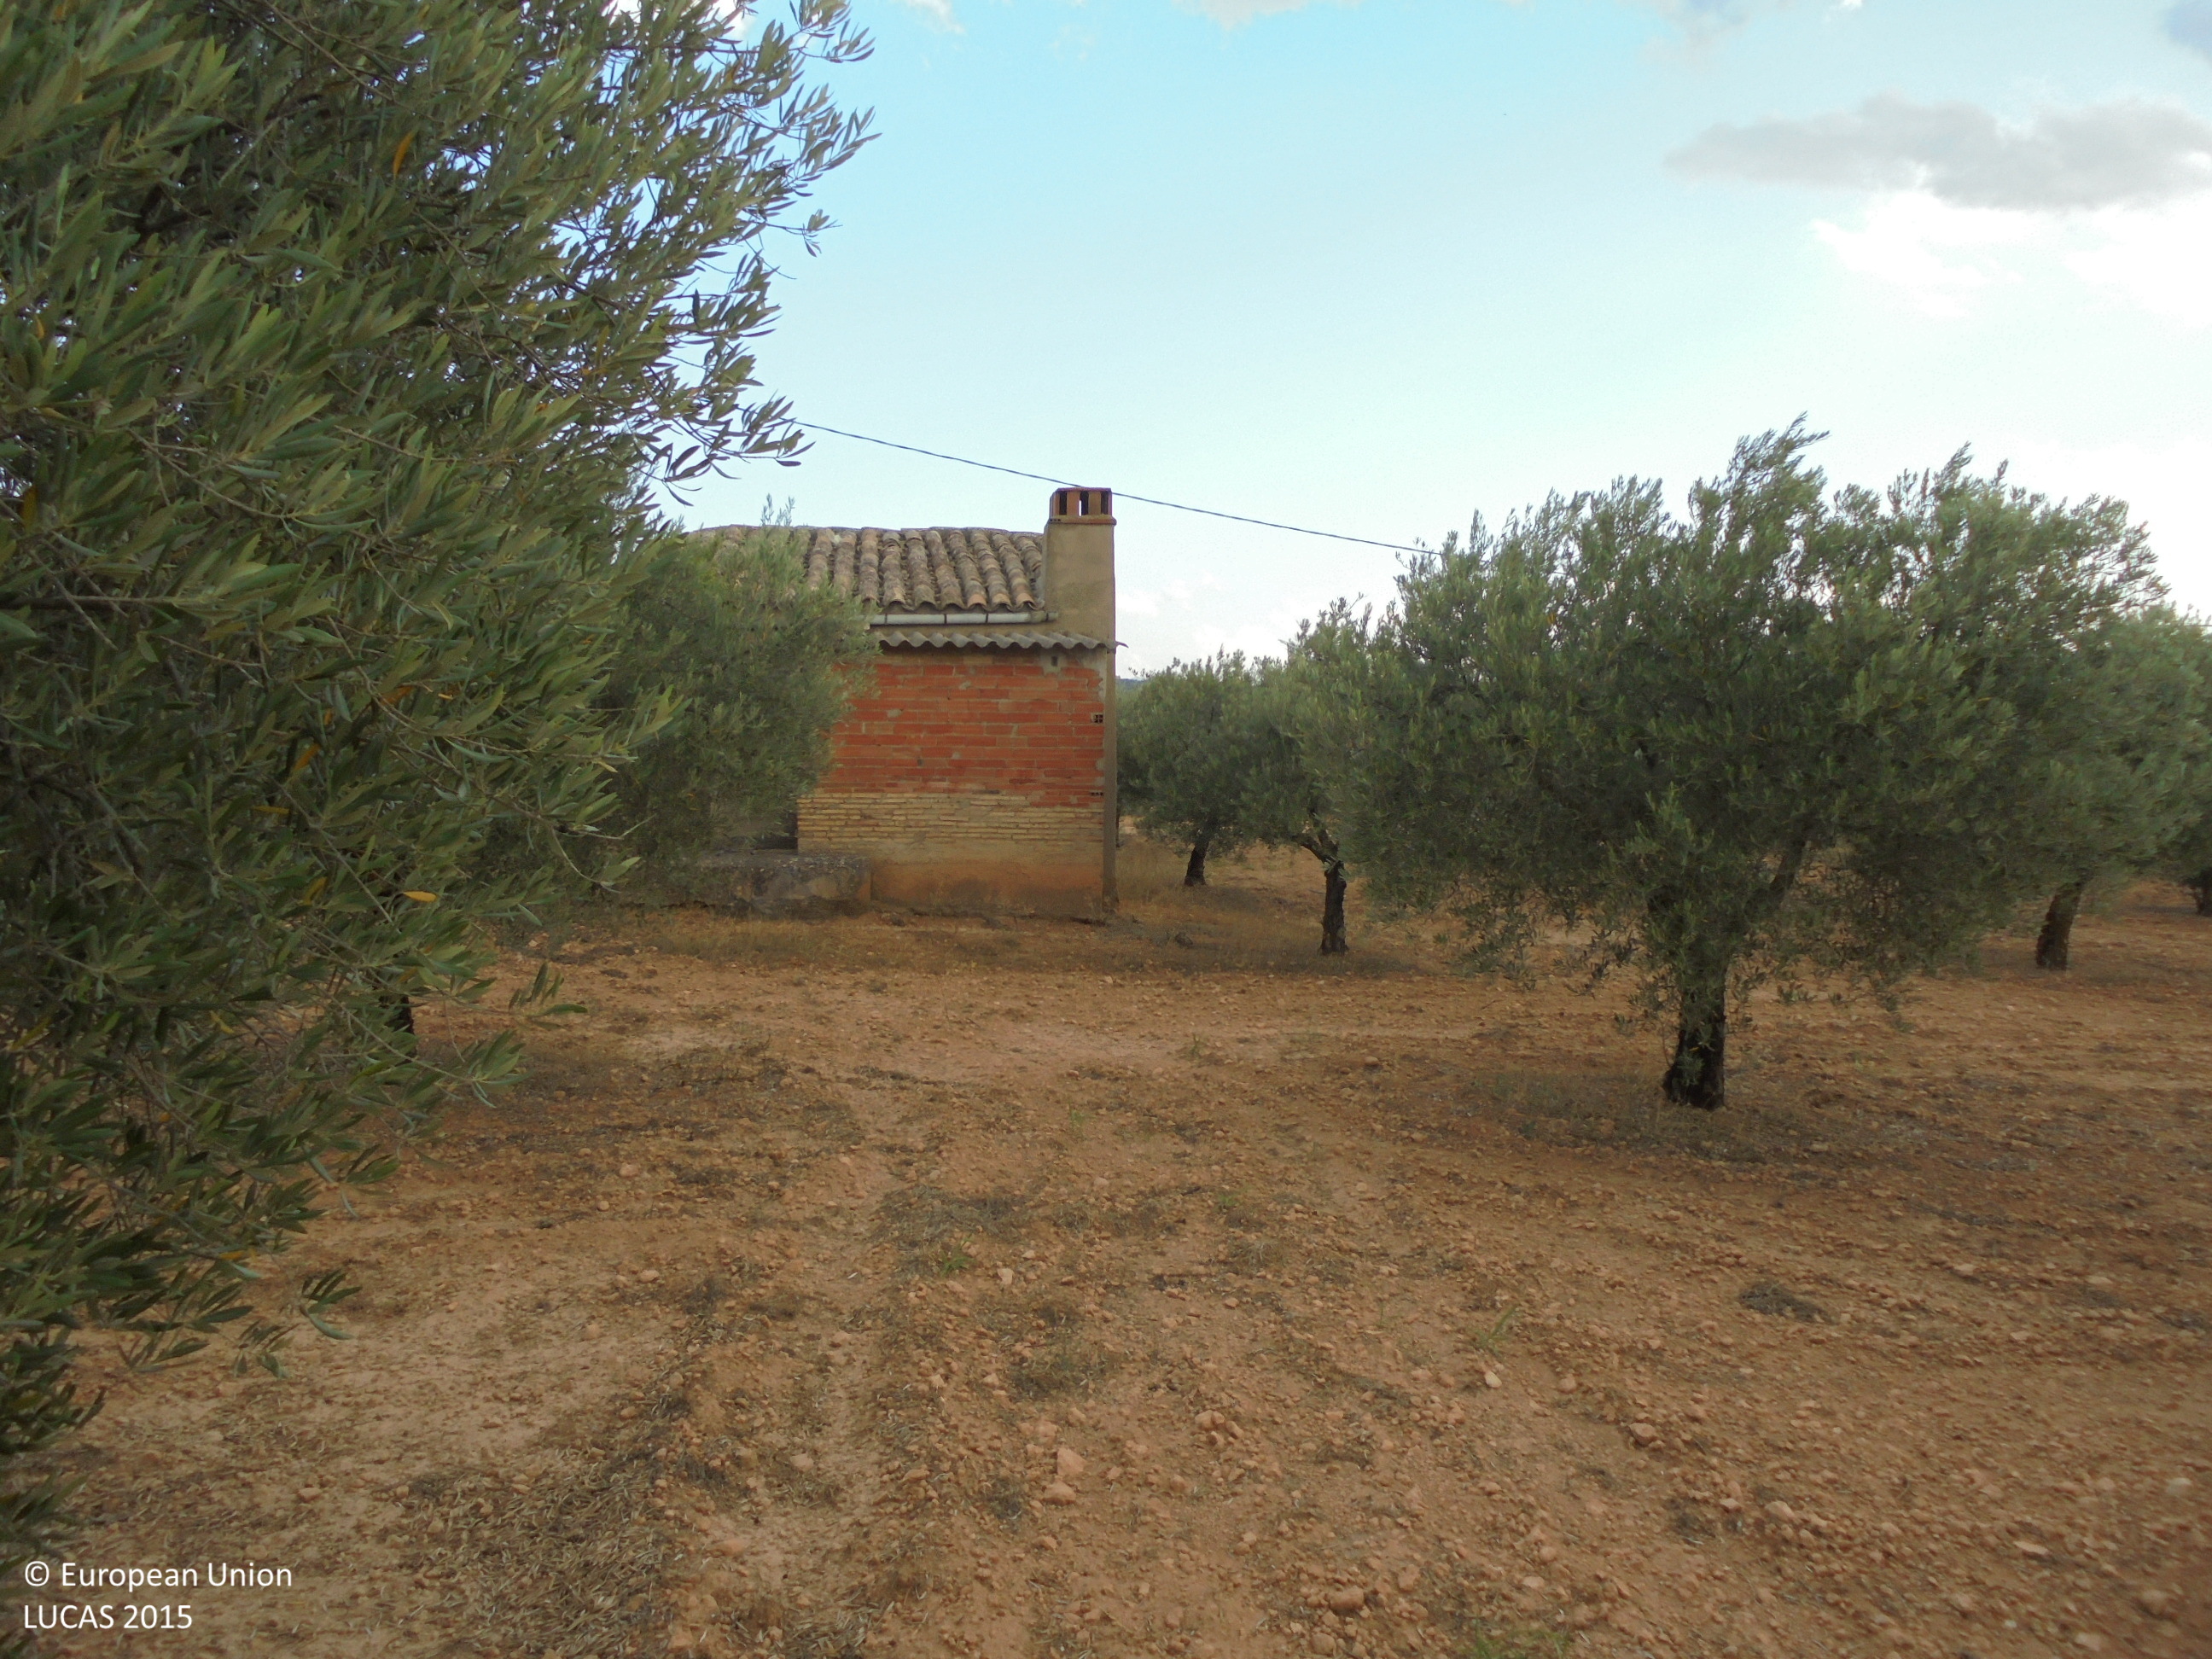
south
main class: Cropland
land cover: Olive groves
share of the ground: 25 - 50 %
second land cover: Other bare soil
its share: > 75 %
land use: Agriculture (excluding fallow land and kitchen gardens)
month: July
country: ES
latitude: 39.0591
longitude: -1.0323
